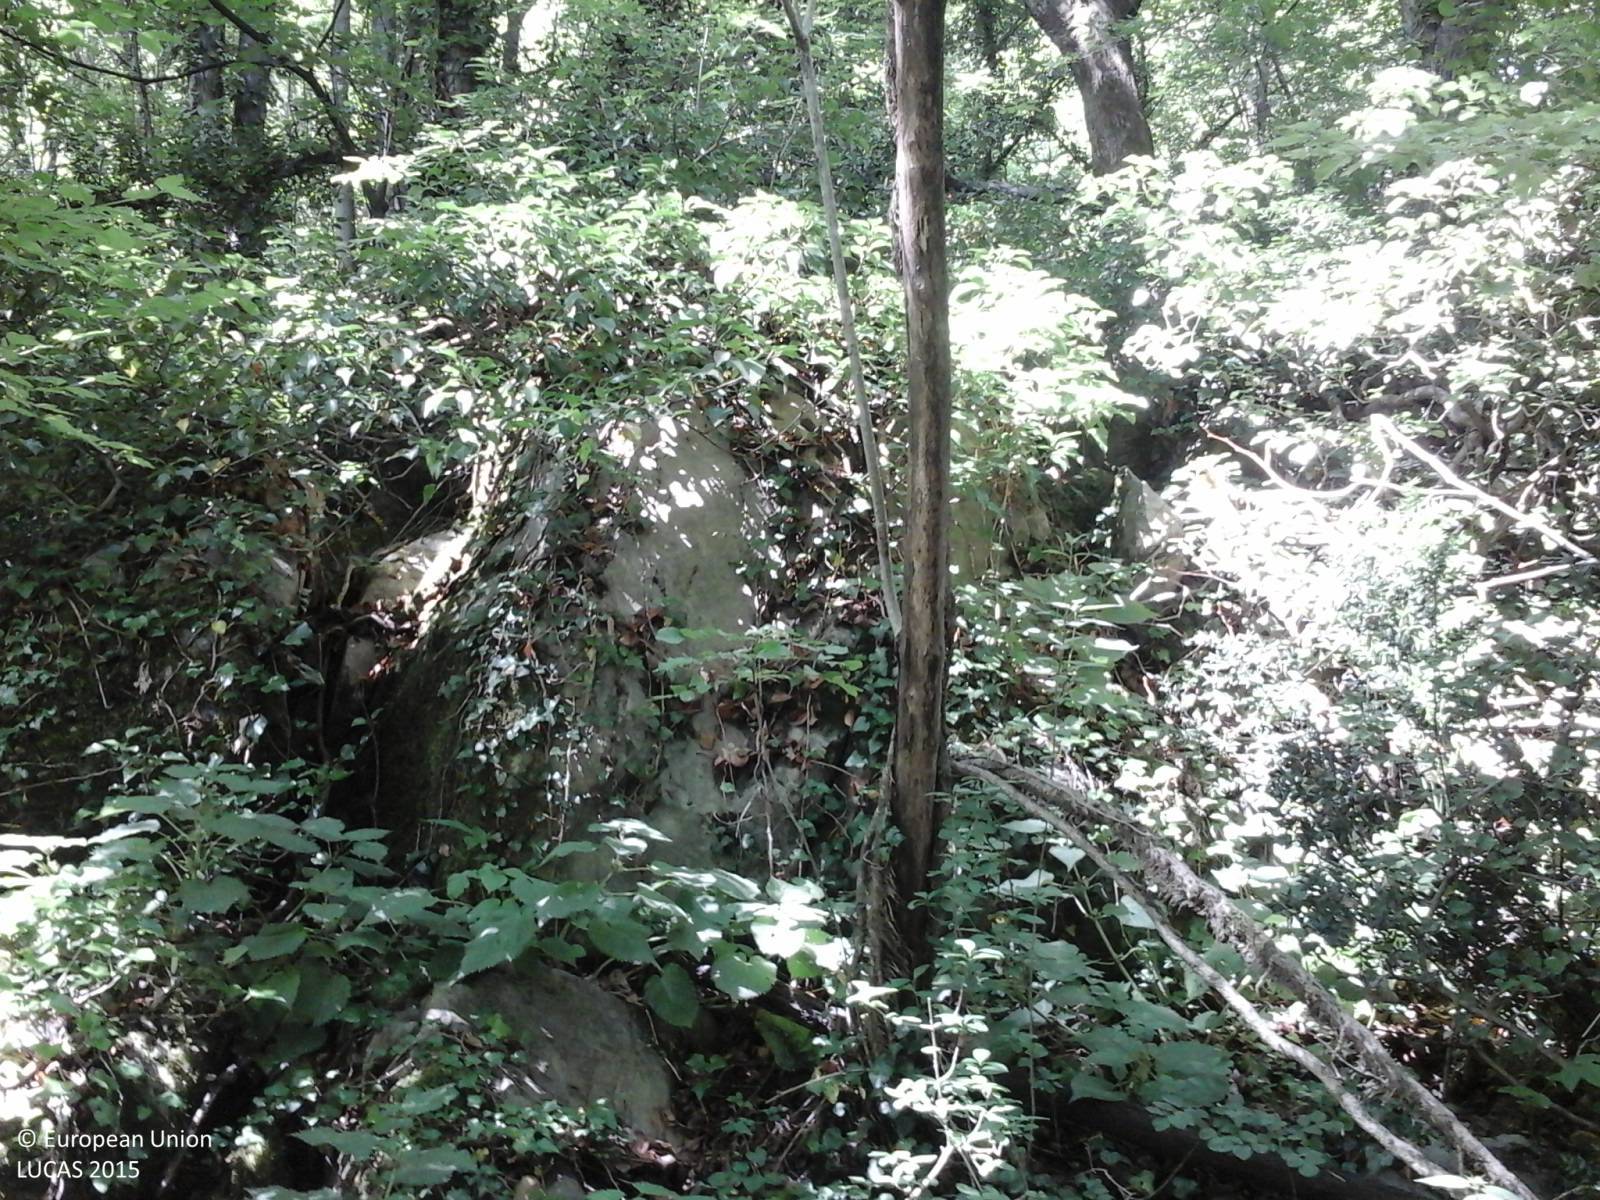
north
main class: Woodland
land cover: Broadleaved woodland
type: mesophytic deciduous forest
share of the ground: > 75 %
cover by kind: broadleaved forest trees 80 %, coniferous forest trees 10 %, shrubs 10 %
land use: Forestry
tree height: > 5 m
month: June
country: IT
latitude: 46.1299
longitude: 13.5557
